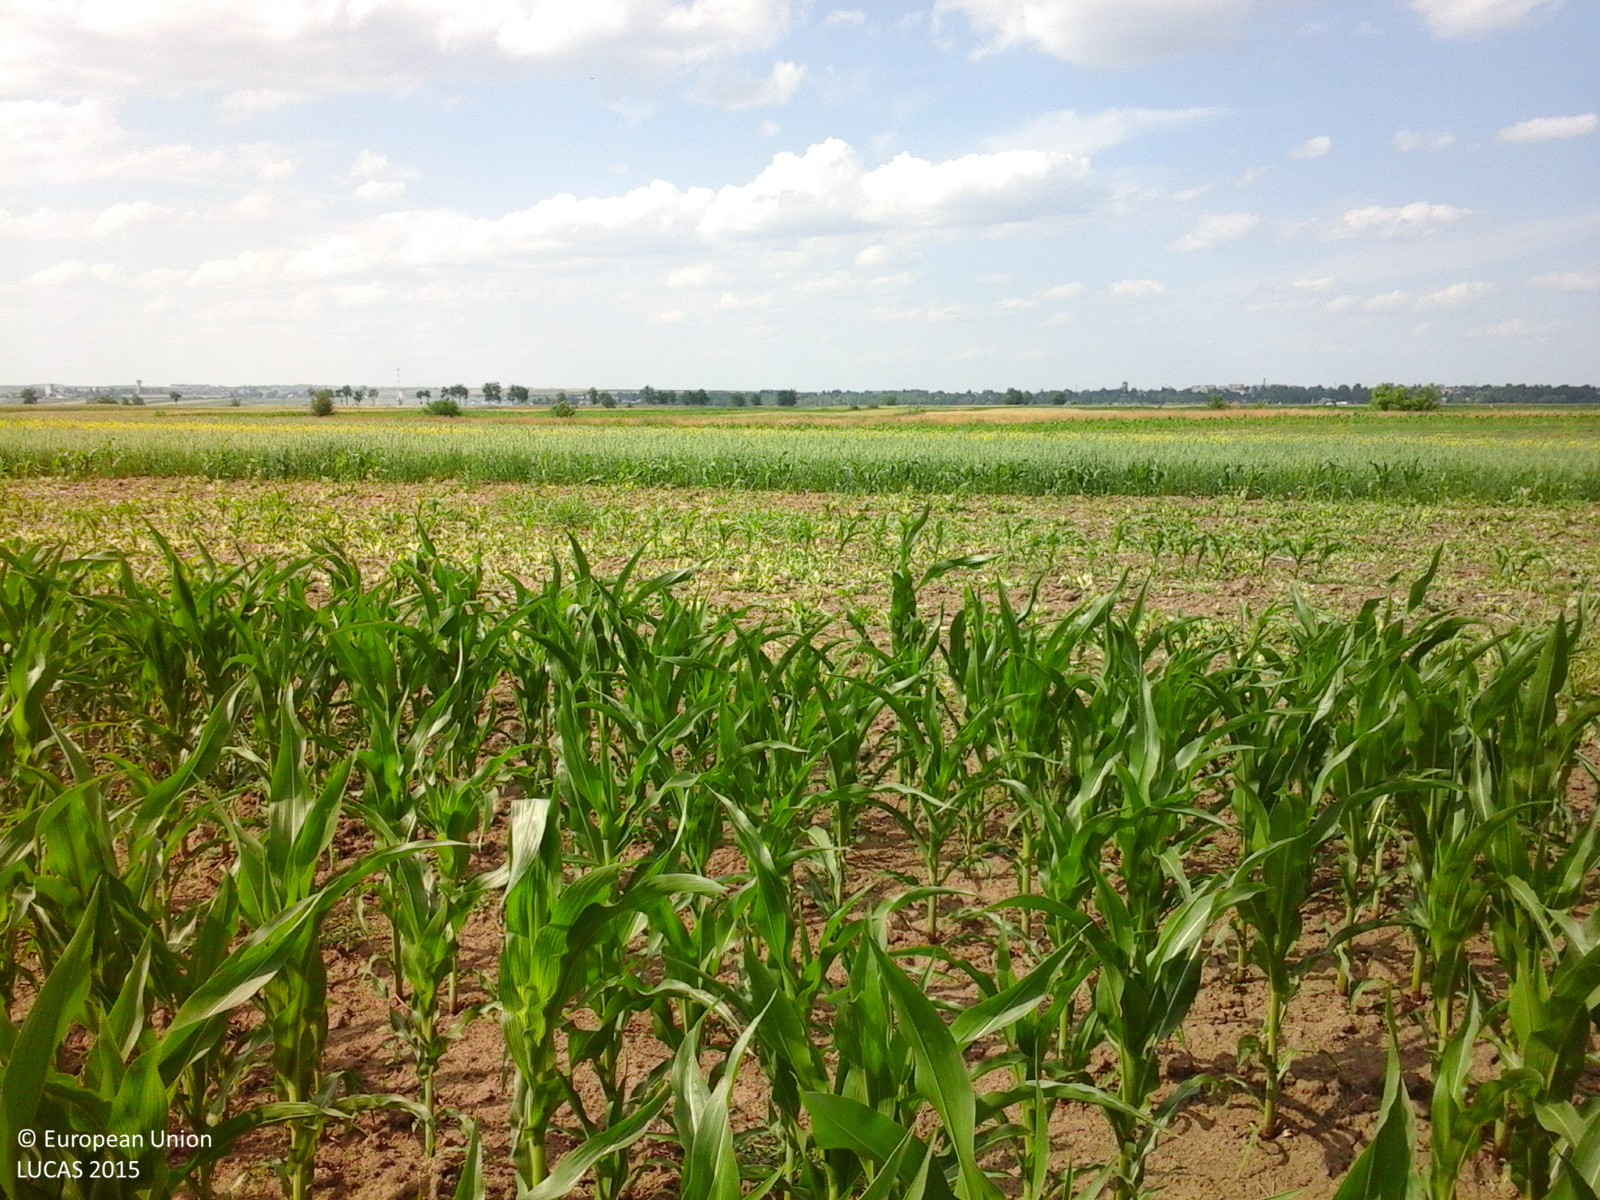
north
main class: Cropland
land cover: Maize
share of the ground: > 75 %
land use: Agriculture (excluding fallow land and kitchen gardens)
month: June
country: RO
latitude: 47.5856
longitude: 26.4292
